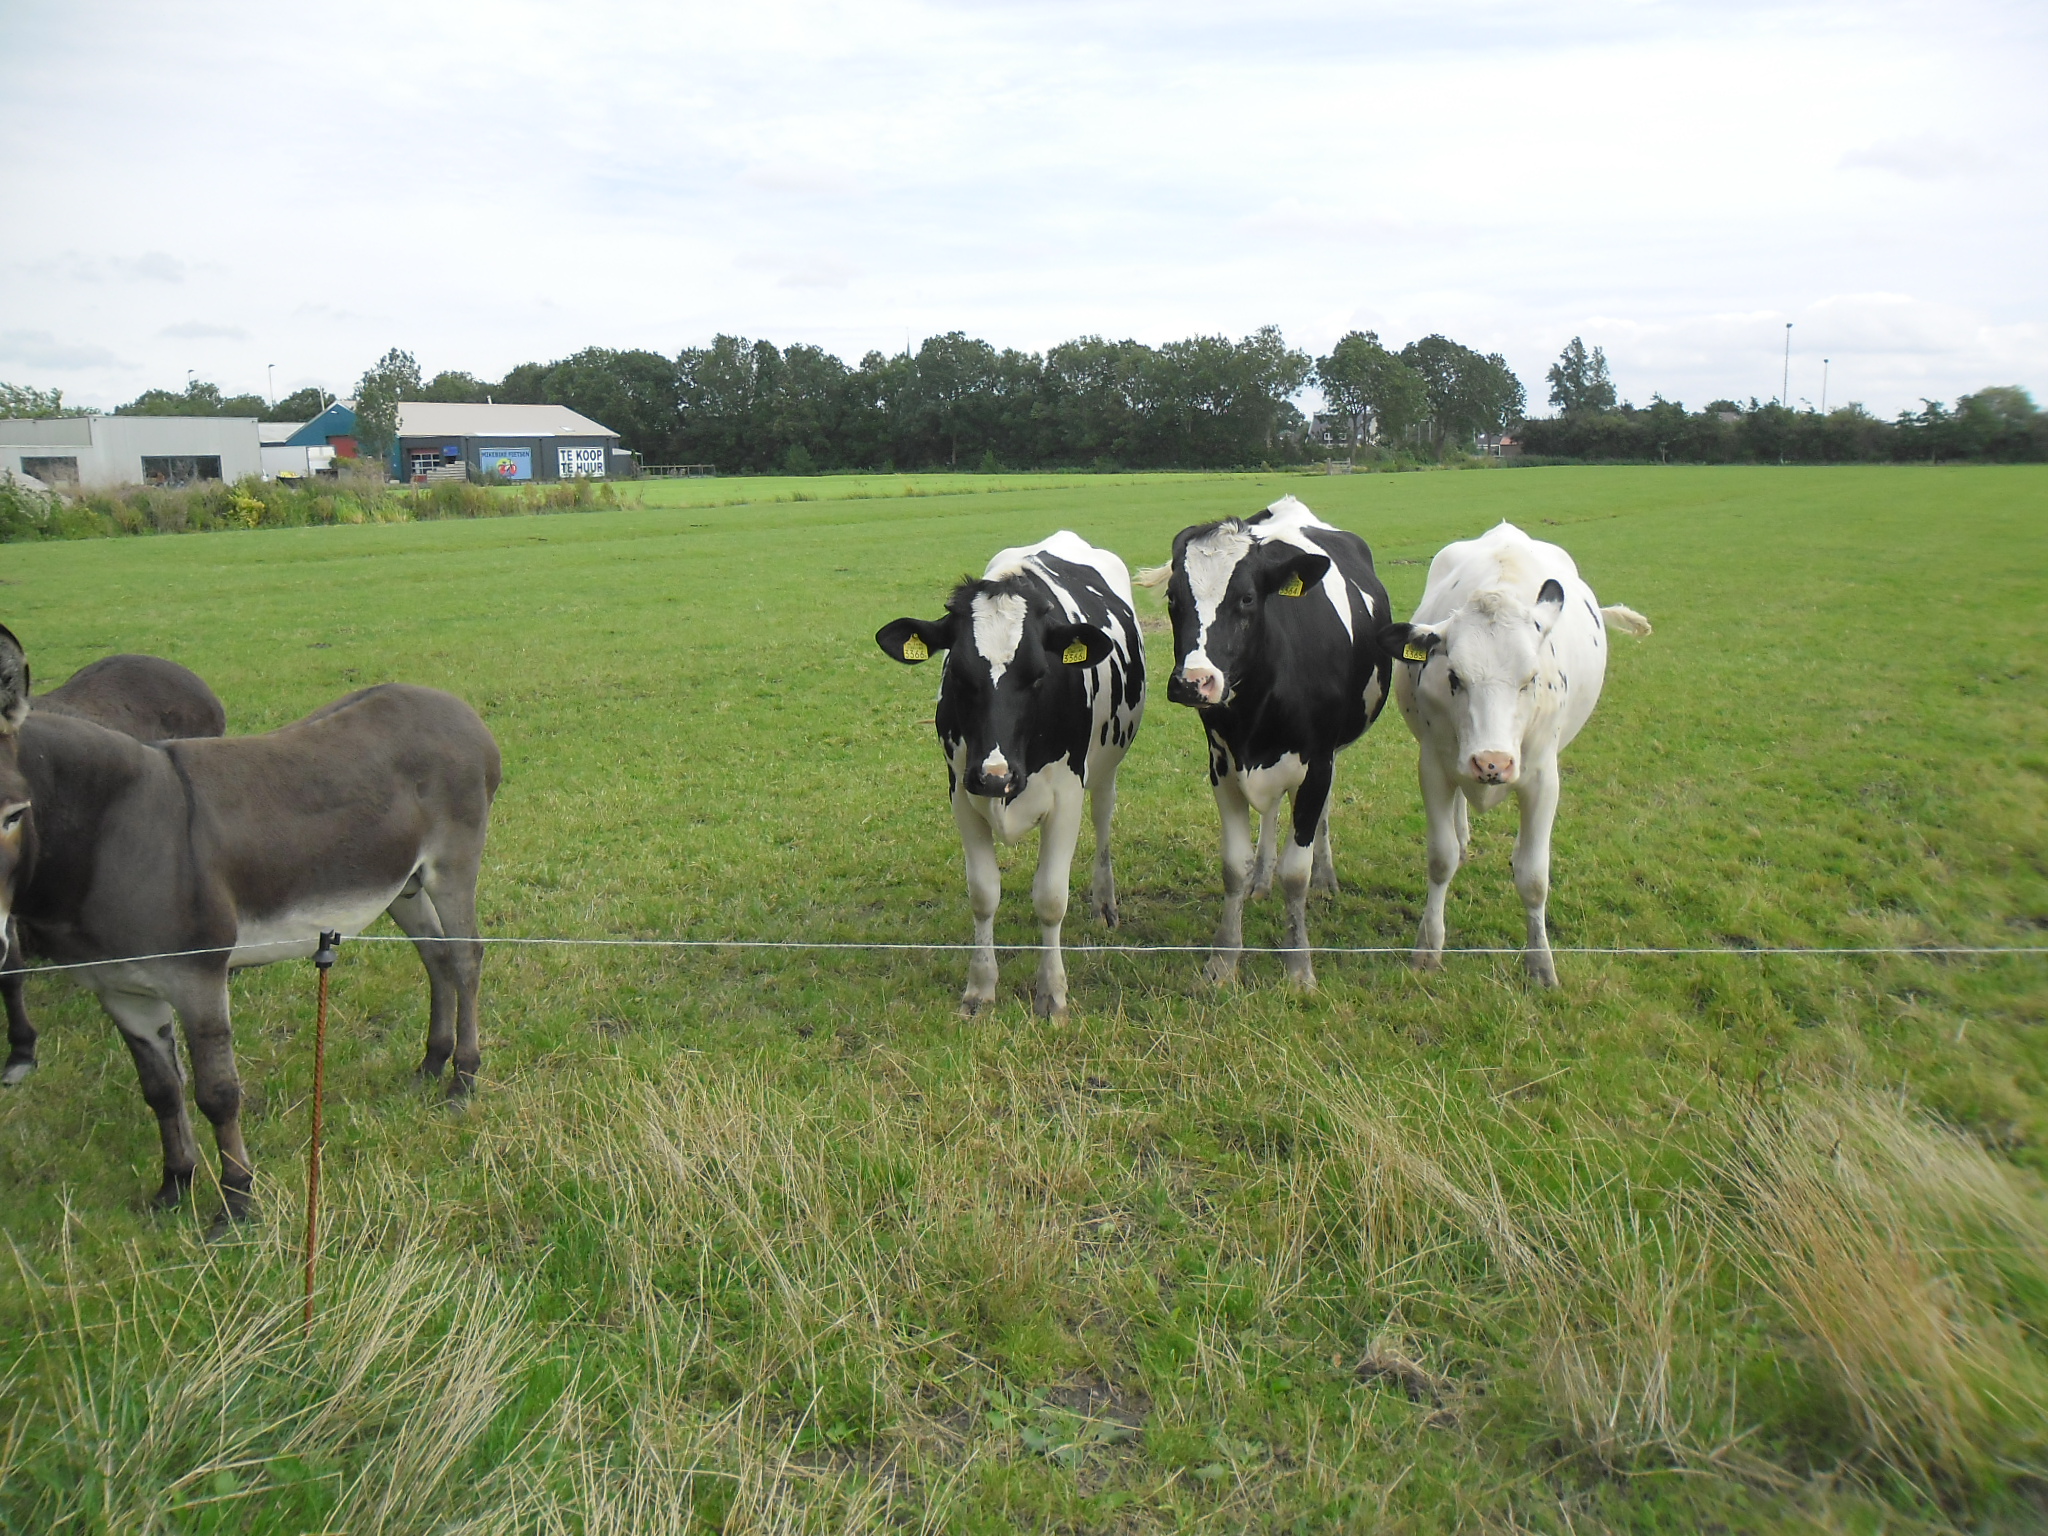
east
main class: Grassland
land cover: Grassland without tree/shrub cover
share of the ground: > 75 %
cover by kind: herbaceous plants 100 %
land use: Agriculture (excluding fallow land and kitchen gardens)
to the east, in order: Grassland without tree/shrub cover; Fences; Grassland without tree/shrub cover; Inland fresh running water; Grassland without tree/shrub cover; Inland fresh running water; Grass margins; Broadleaved woodland; Artificial constructions in urban areas
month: August
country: NL
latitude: 53.0509
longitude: 5.5681
